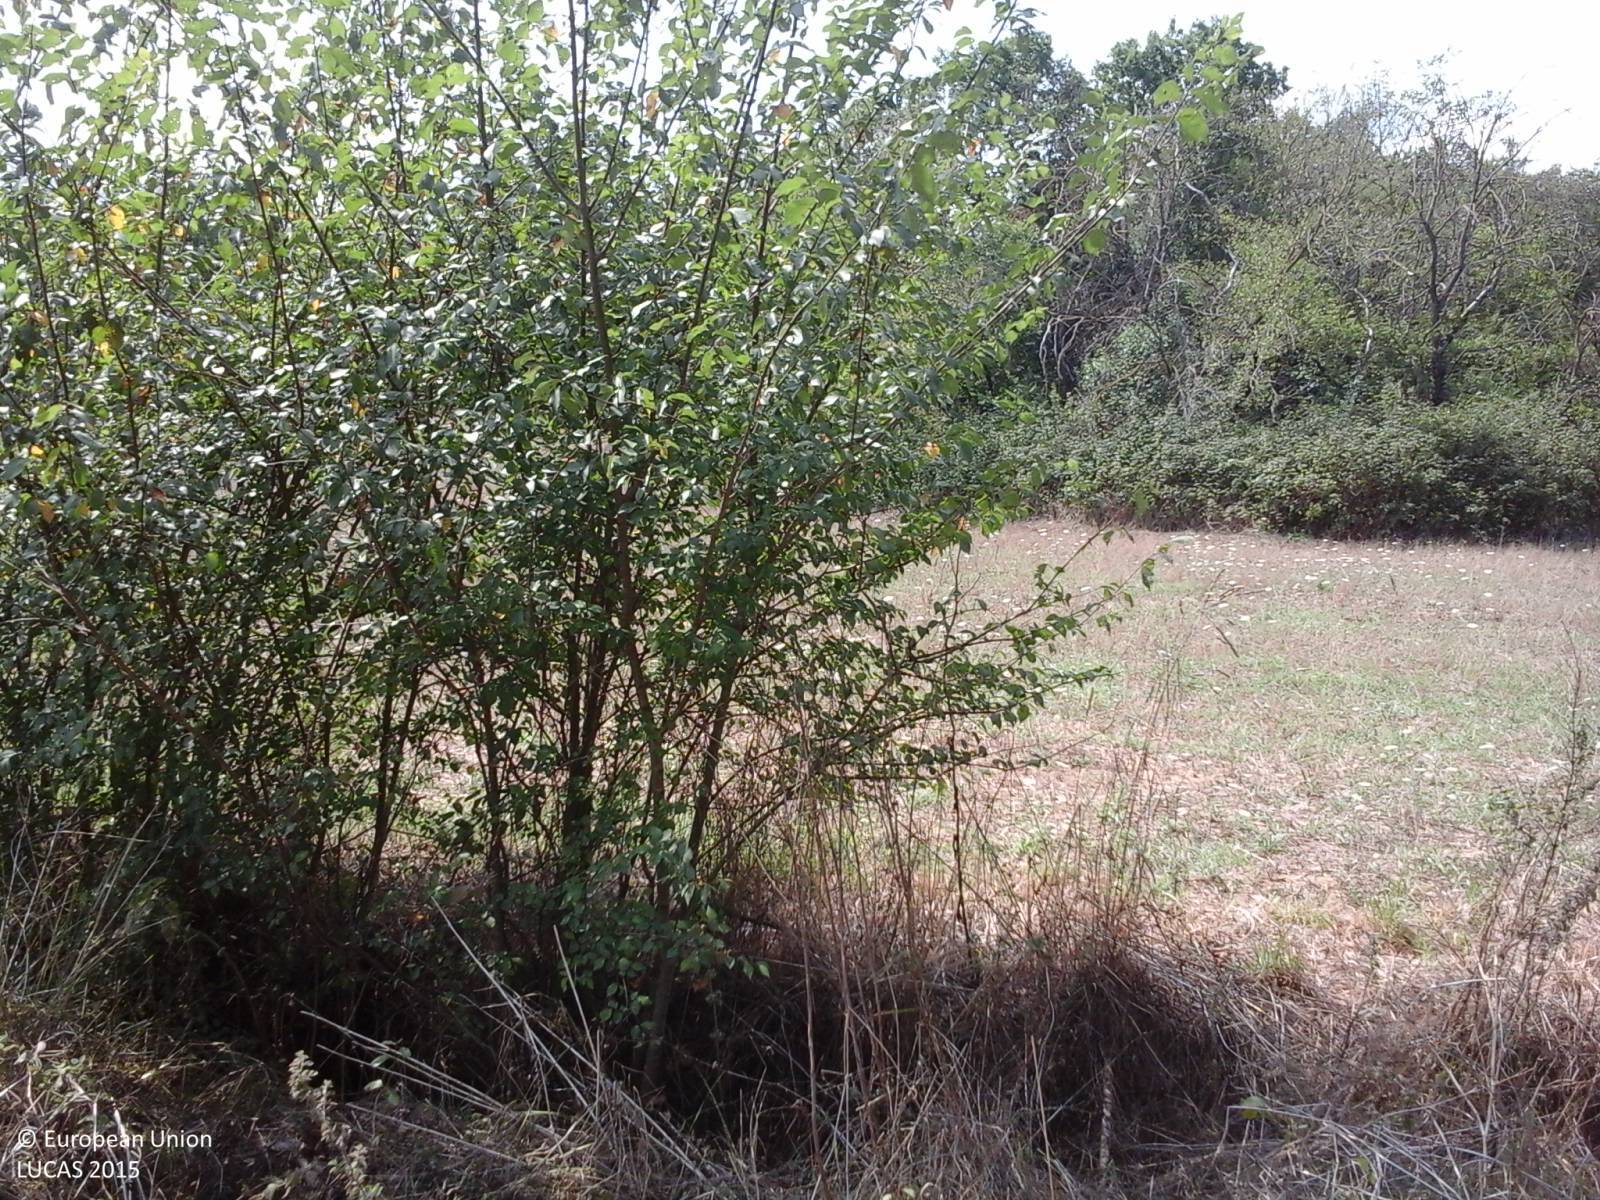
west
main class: Grassland
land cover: Grassland with sparse tree/shrub cover
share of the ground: > 75 %
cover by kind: herbaceous plants 75 %, unconsolidated bare surface 20 %, broadleaved forest trees 5 %
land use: Semi-natural and natural areas not in use
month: August
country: IT
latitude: 41.4782
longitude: 13.3282
